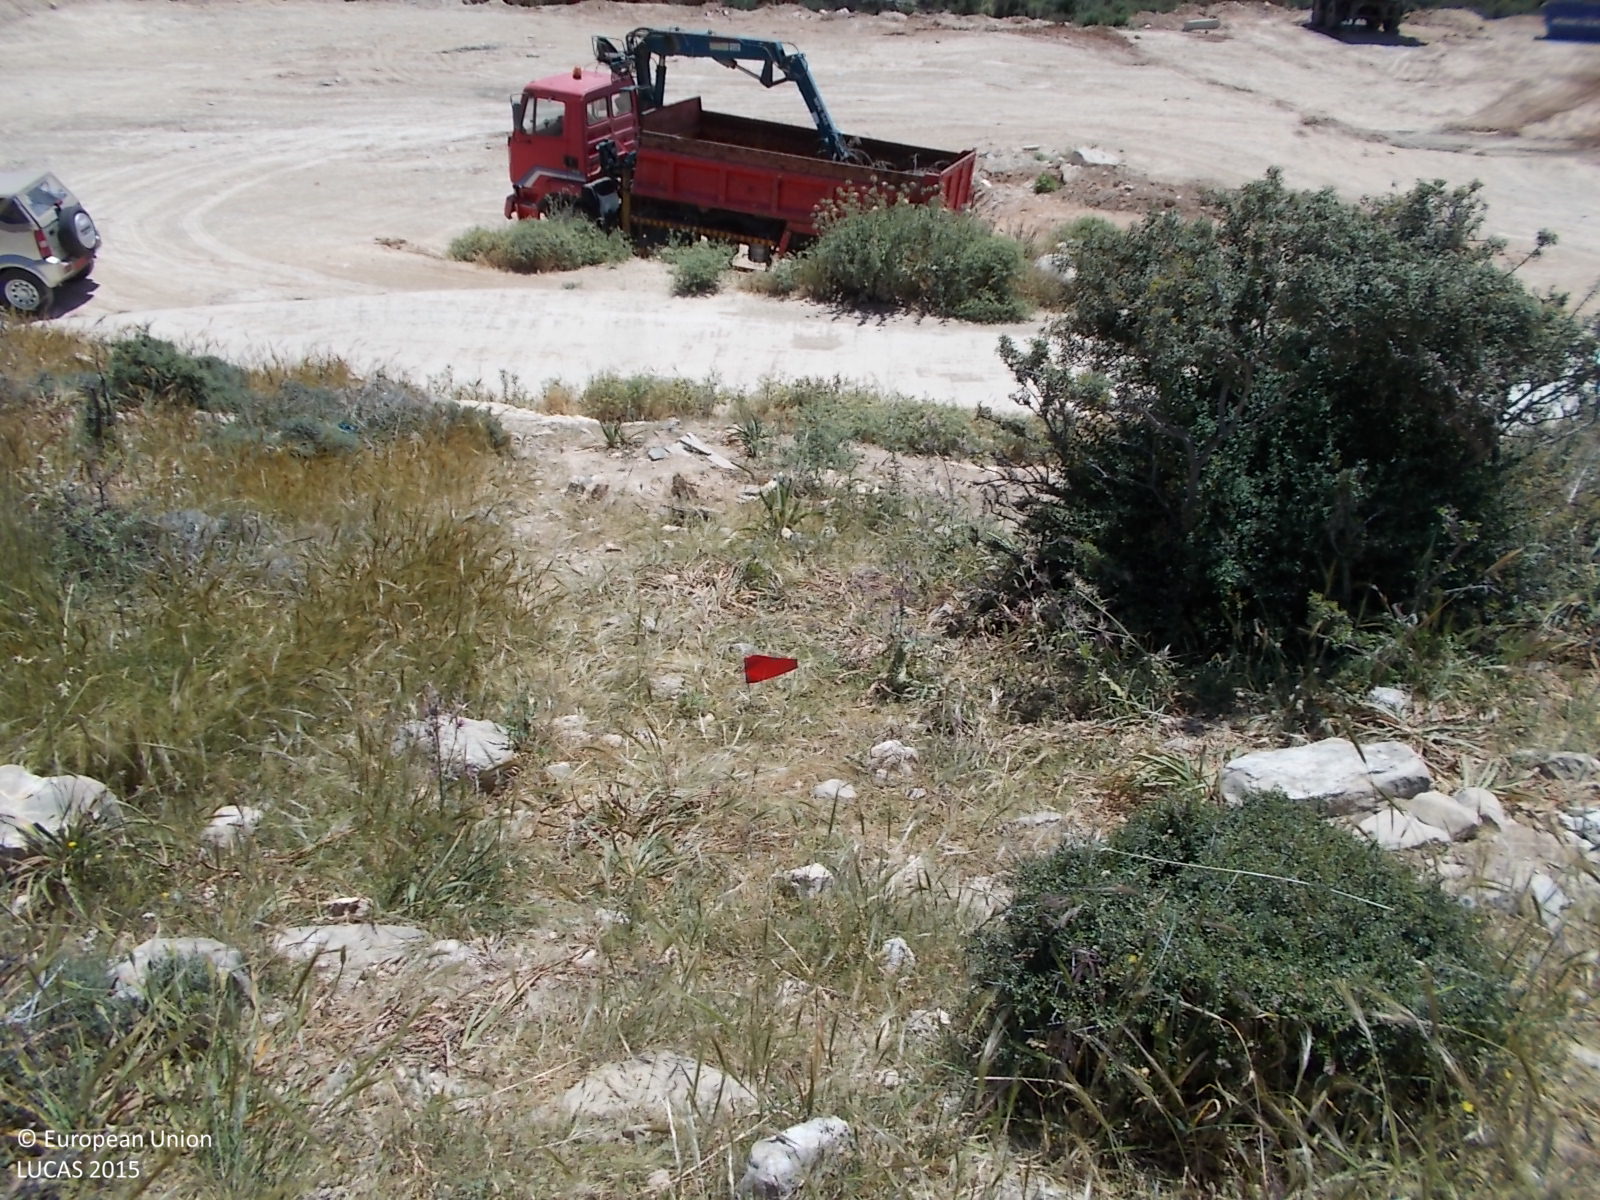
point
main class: Shrubland
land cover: Shrubland without tree cover
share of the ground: > 75 %
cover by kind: shrubs 75 %, herbaceous plants 15 %, unconsolidated bare surface 10 %
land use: Agriculture (excluding fallow land and kitchen gardens)
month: April
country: CY
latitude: 34.7274
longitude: 33.1134
